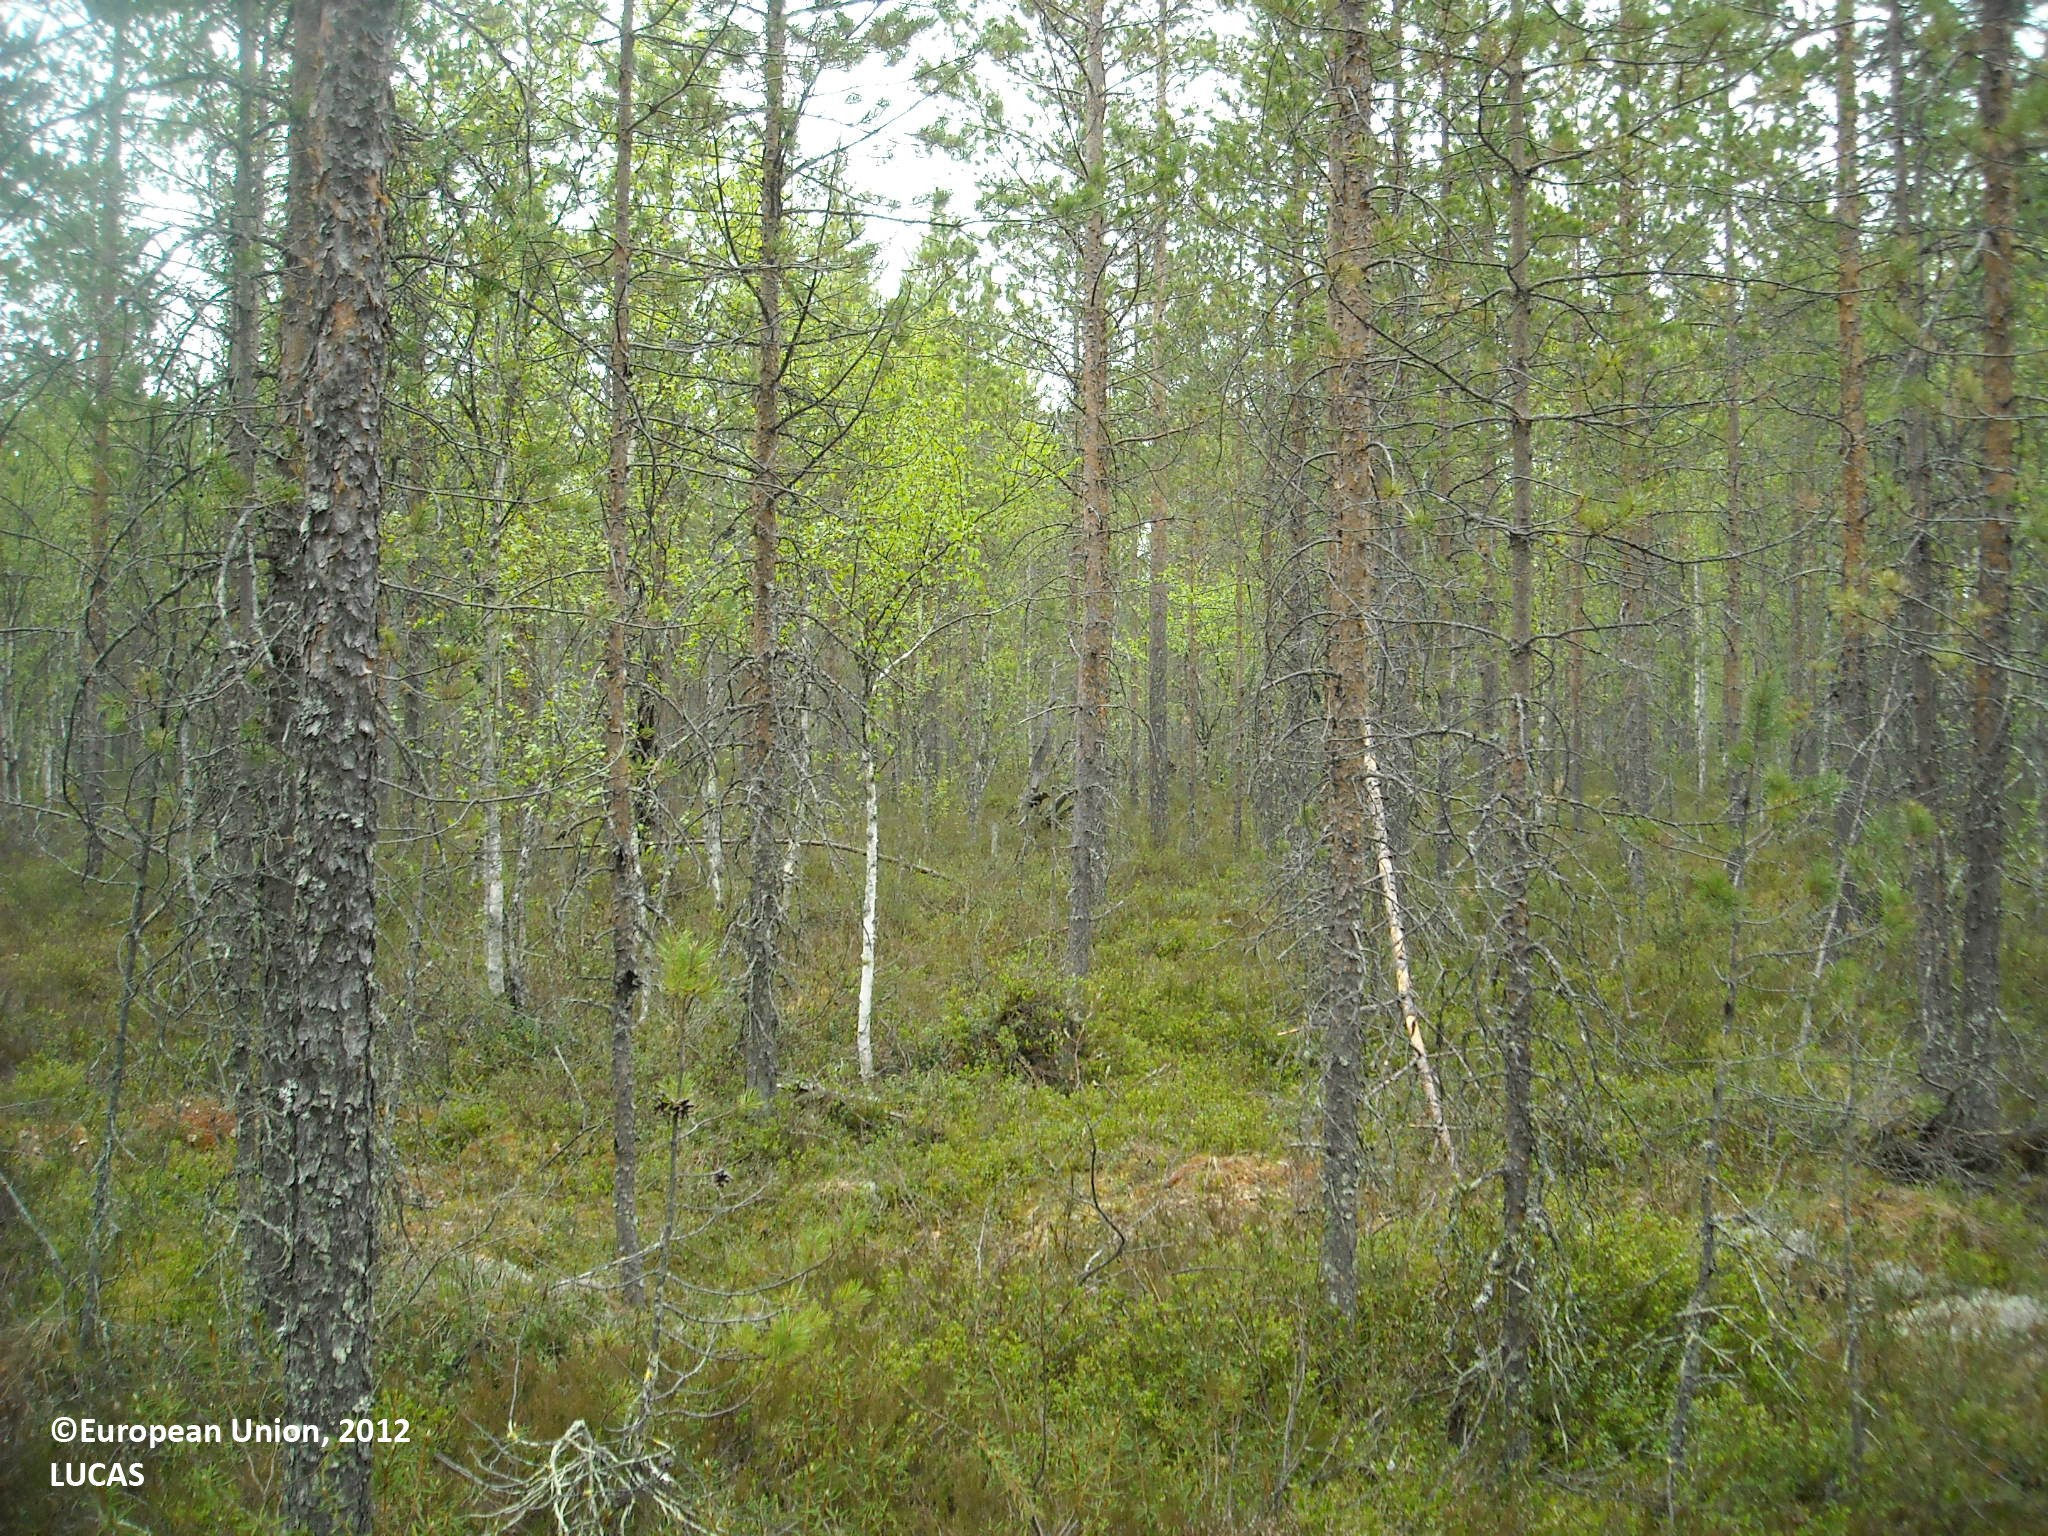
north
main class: Woodland
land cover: Pine dominated coniferous woodland
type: mire and swamp forests
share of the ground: > 75 %
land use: Forestry
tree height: > 5 m
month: June
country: FI
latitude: 64.6432
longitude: 27.3177
